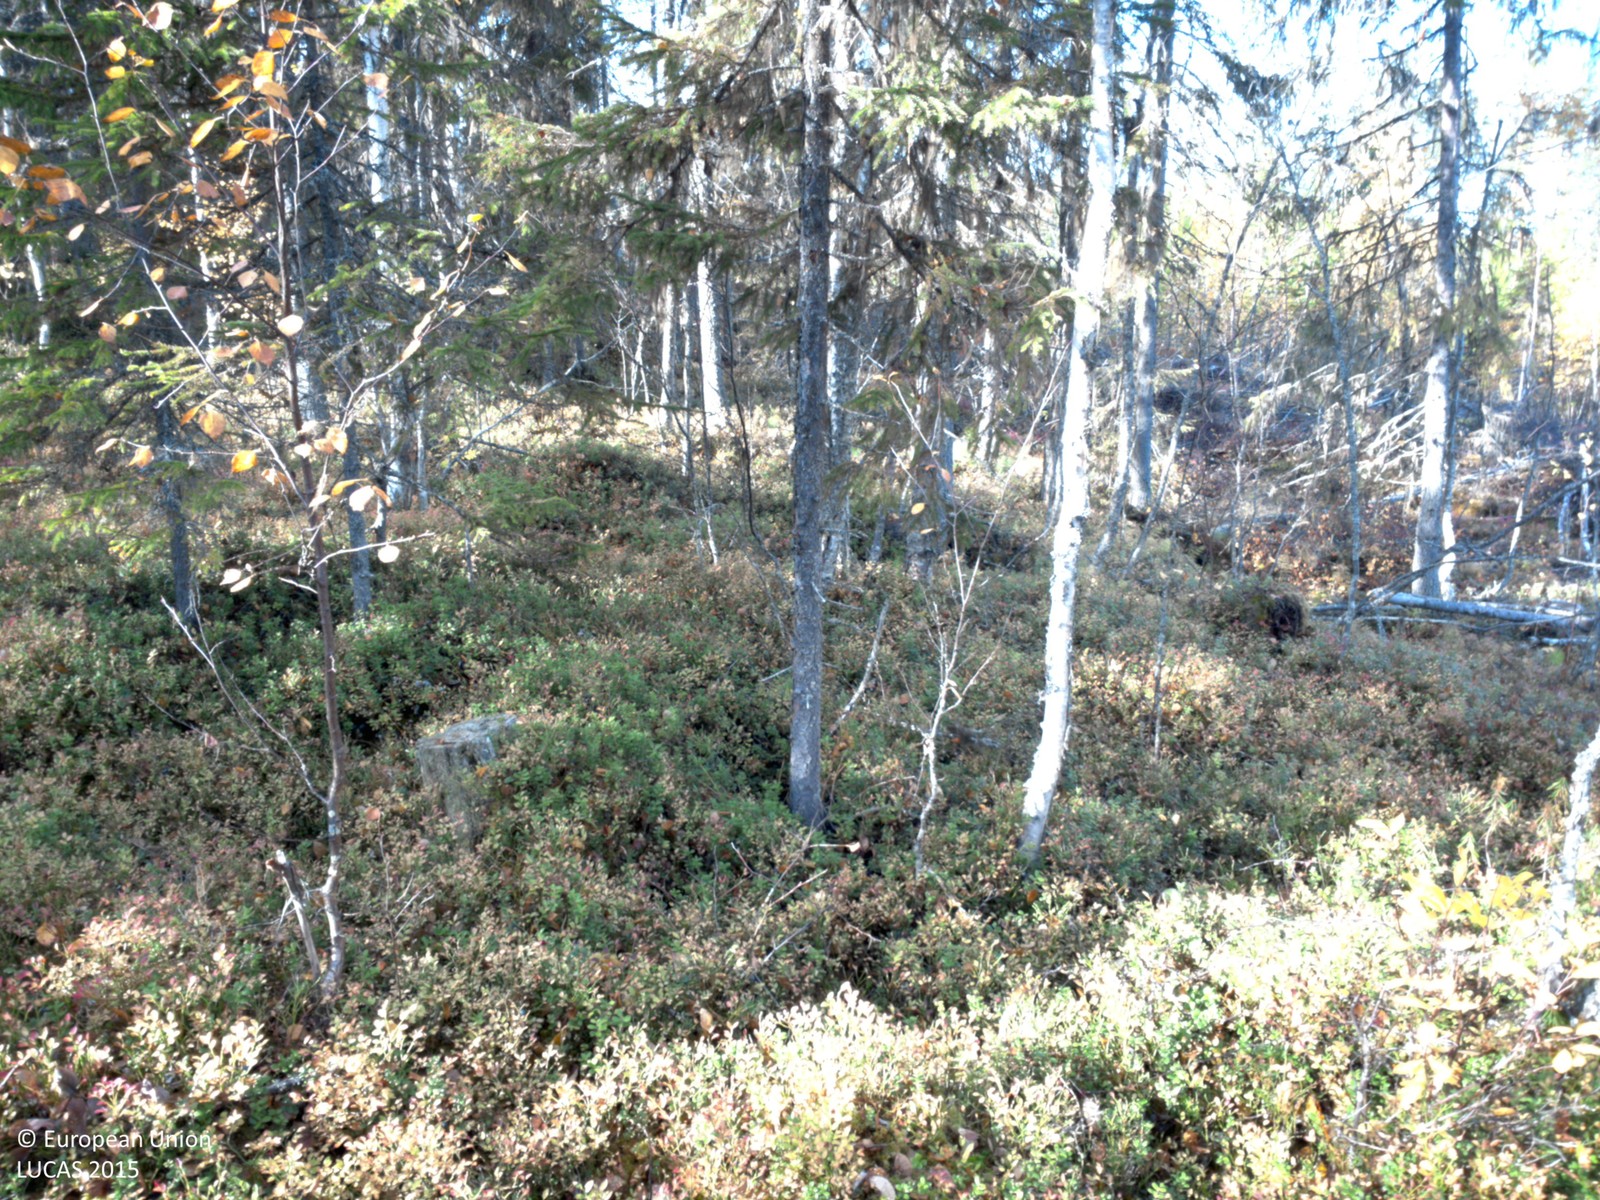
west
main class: Woodland
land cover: Other mixed woodland
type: boreal forest
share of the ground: 50 - 75 %
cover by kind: coniferous forest trees 45 %, shrubs 40 %, broadleaved forest trees 15 %
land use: Forestry
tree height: > 5 m
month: September
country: SE
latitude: 64.8069
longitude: 18.4931
